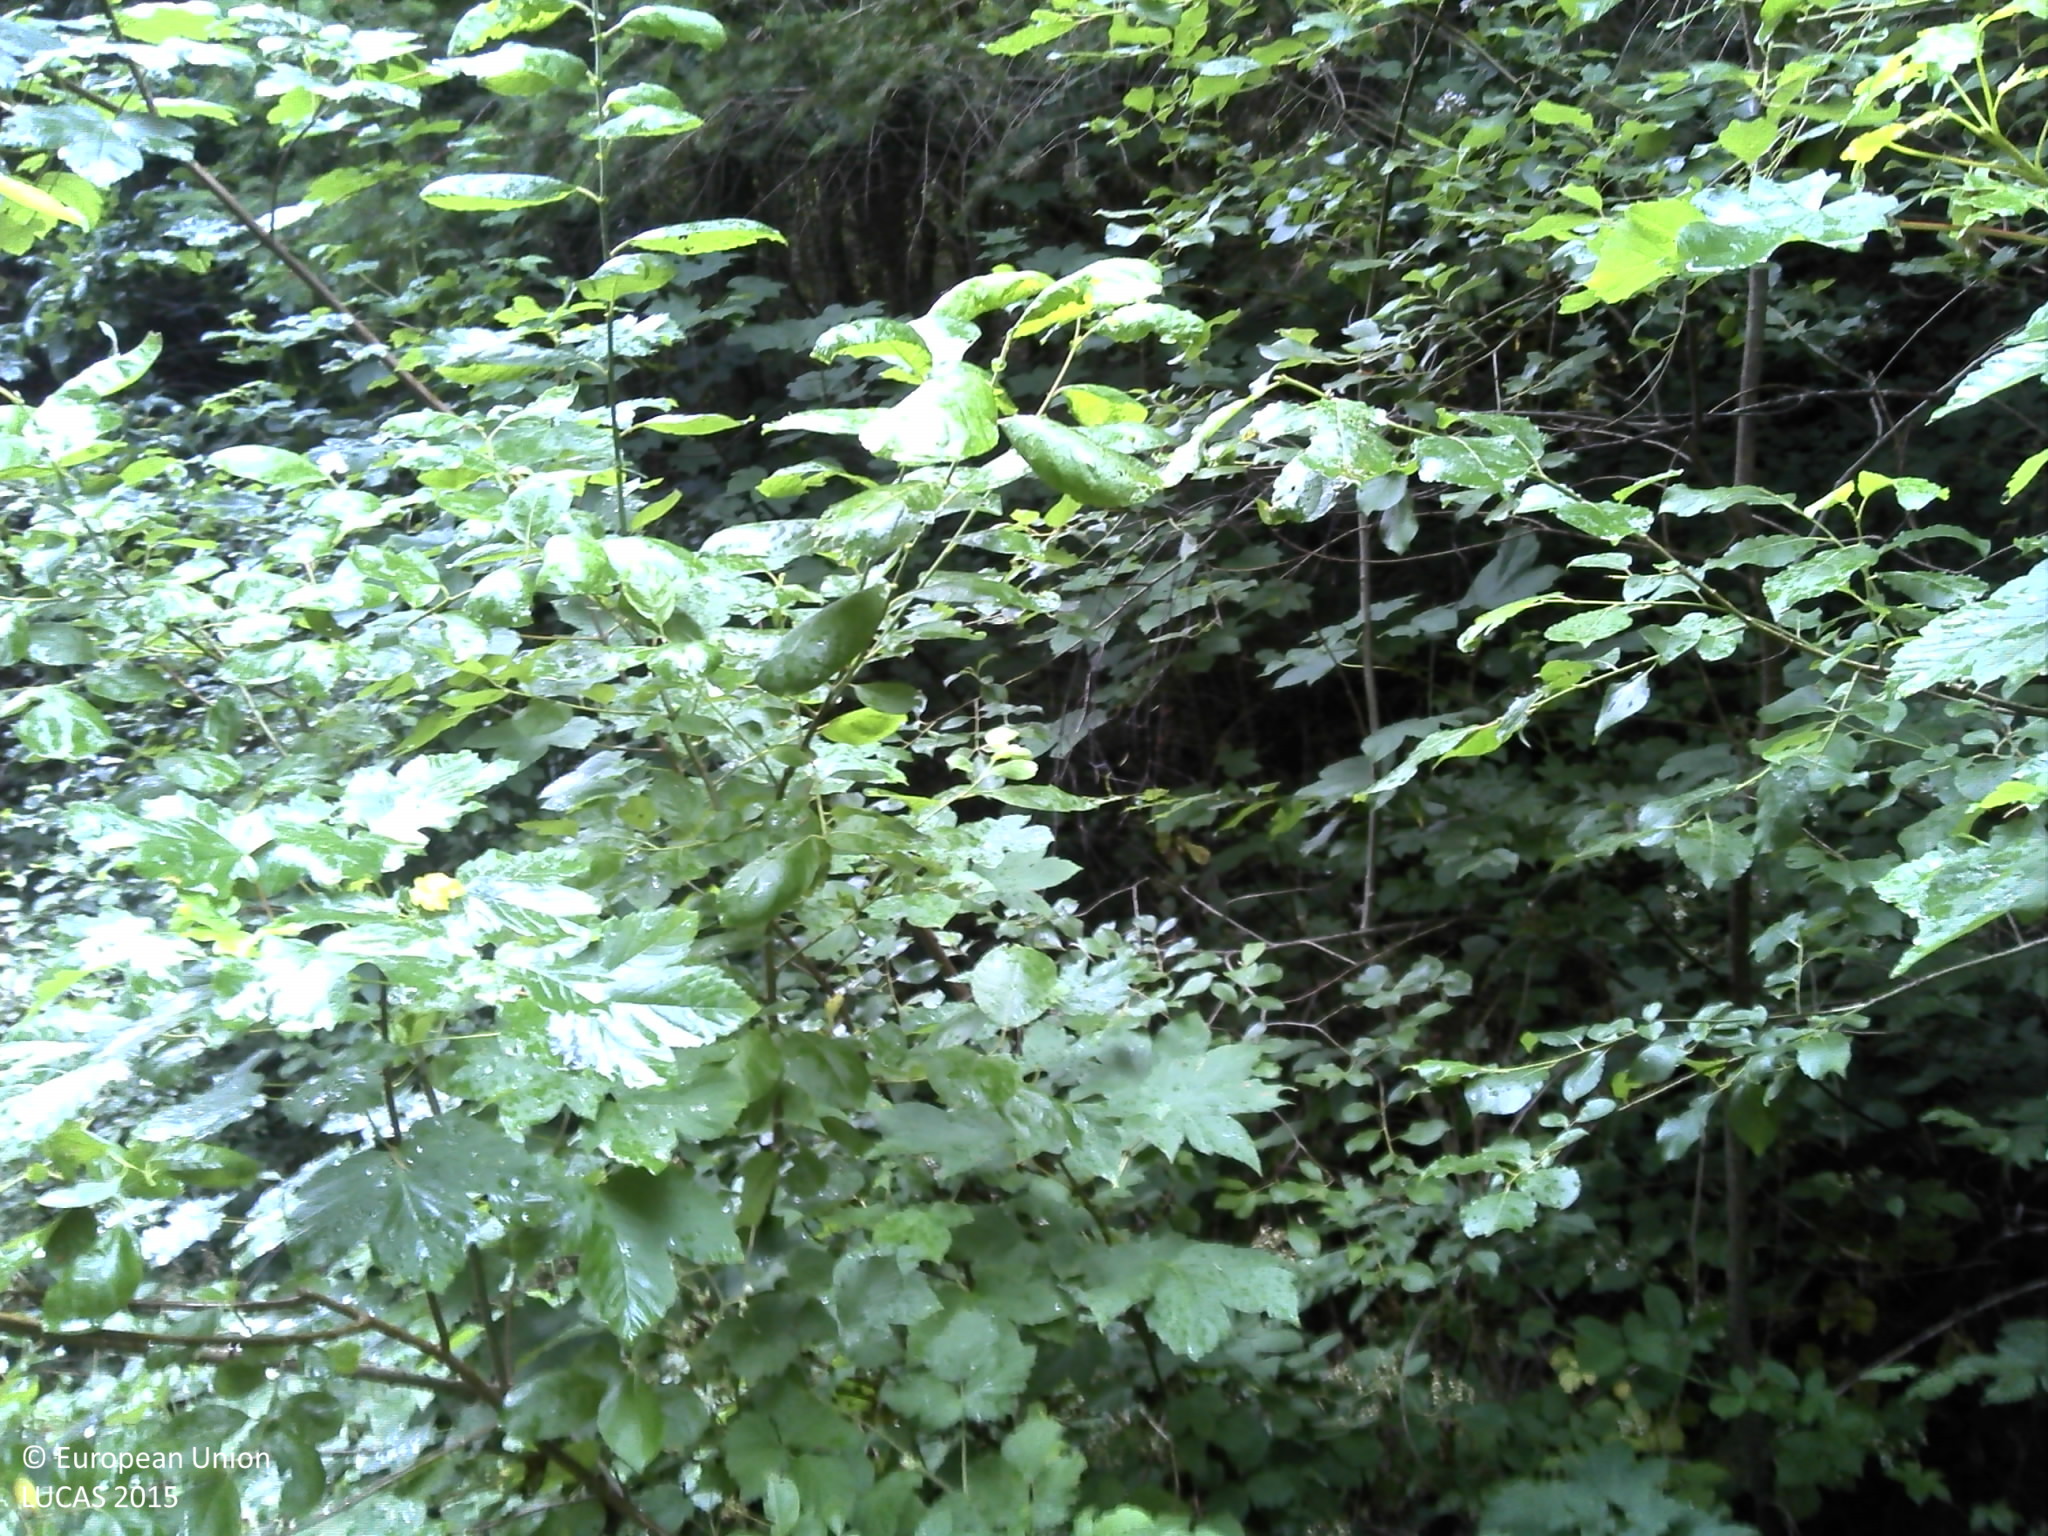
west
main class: Woodland
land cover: Broadleaved woodland
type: mesophytic deciduous forest
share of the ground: > 75 %
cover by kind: broadleaved forest trees 70 %, herbaceous plants 25 %, consolidated bare surface 5 %
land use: Forestry
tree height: > 5 m
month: July
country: FR
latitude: 49.8319
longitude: 4.8113
